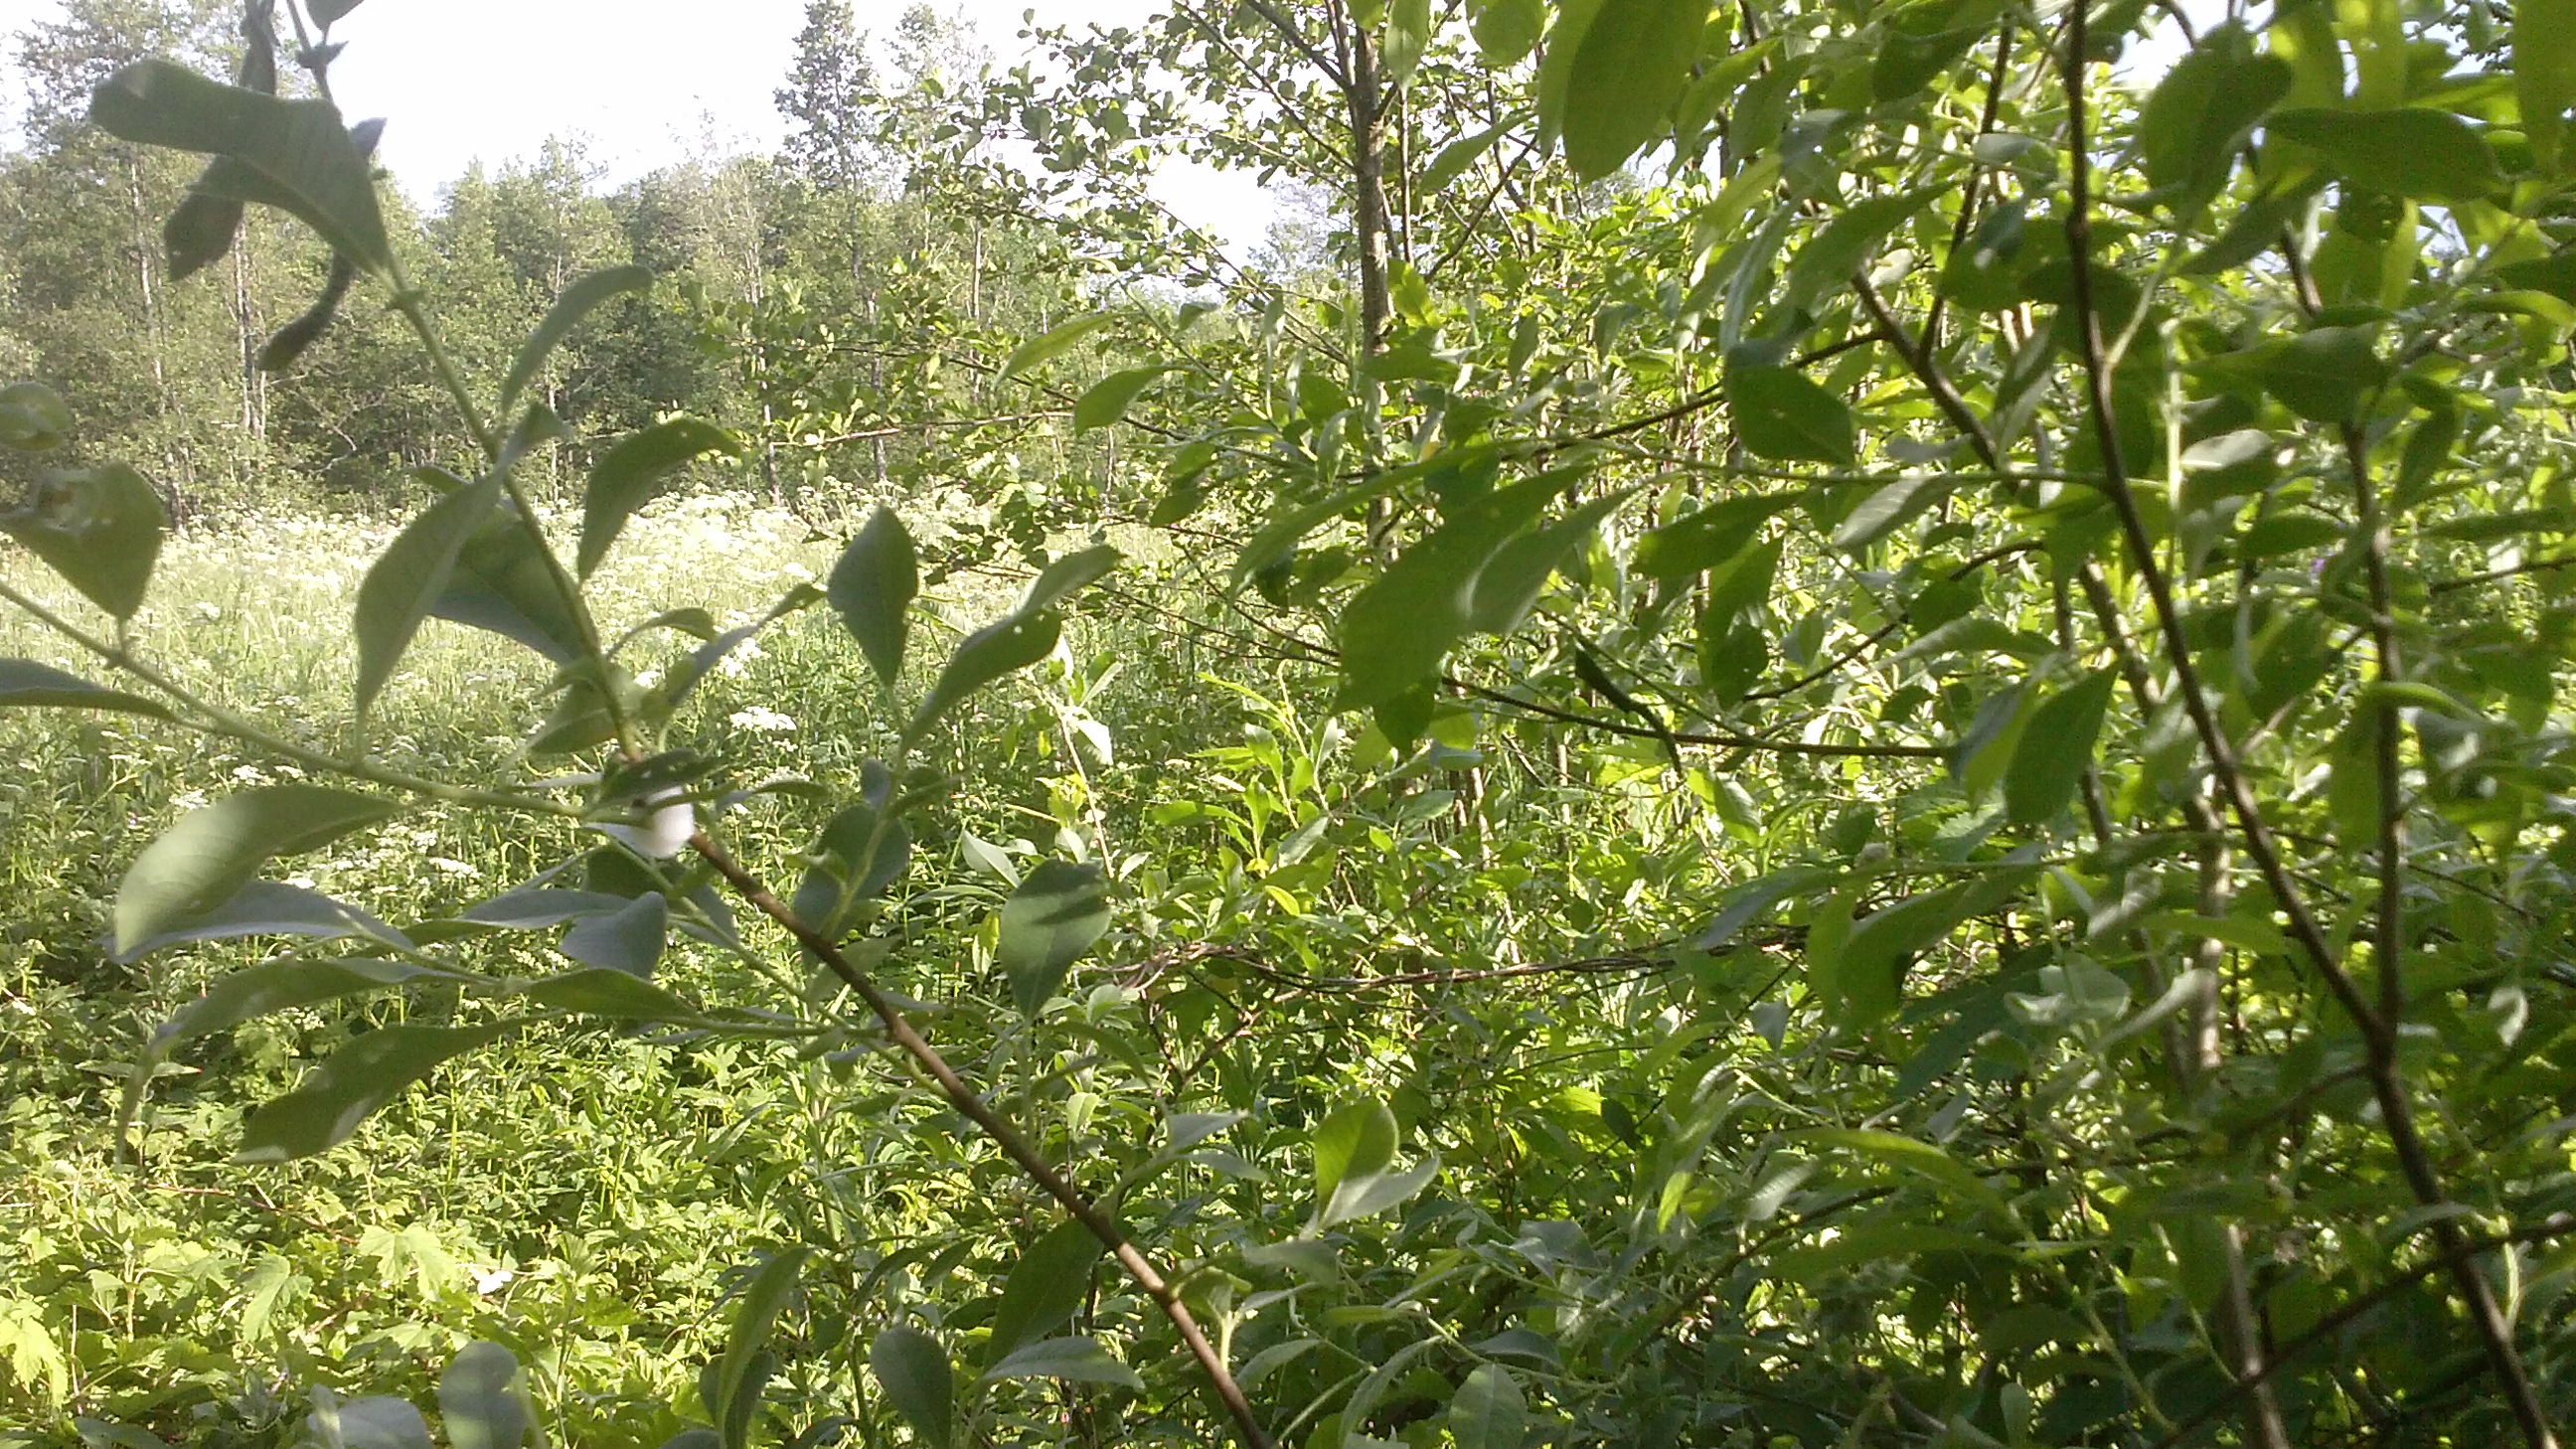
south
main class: Woodland
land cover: Broadleaved woodland
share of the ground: > 75 %
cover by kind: broadleaved forest trees 80 %, shrubs 20 %
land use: Semi-natural and natural areas not in use
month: June
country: LV
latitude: 56.4399
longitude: 27.4184
